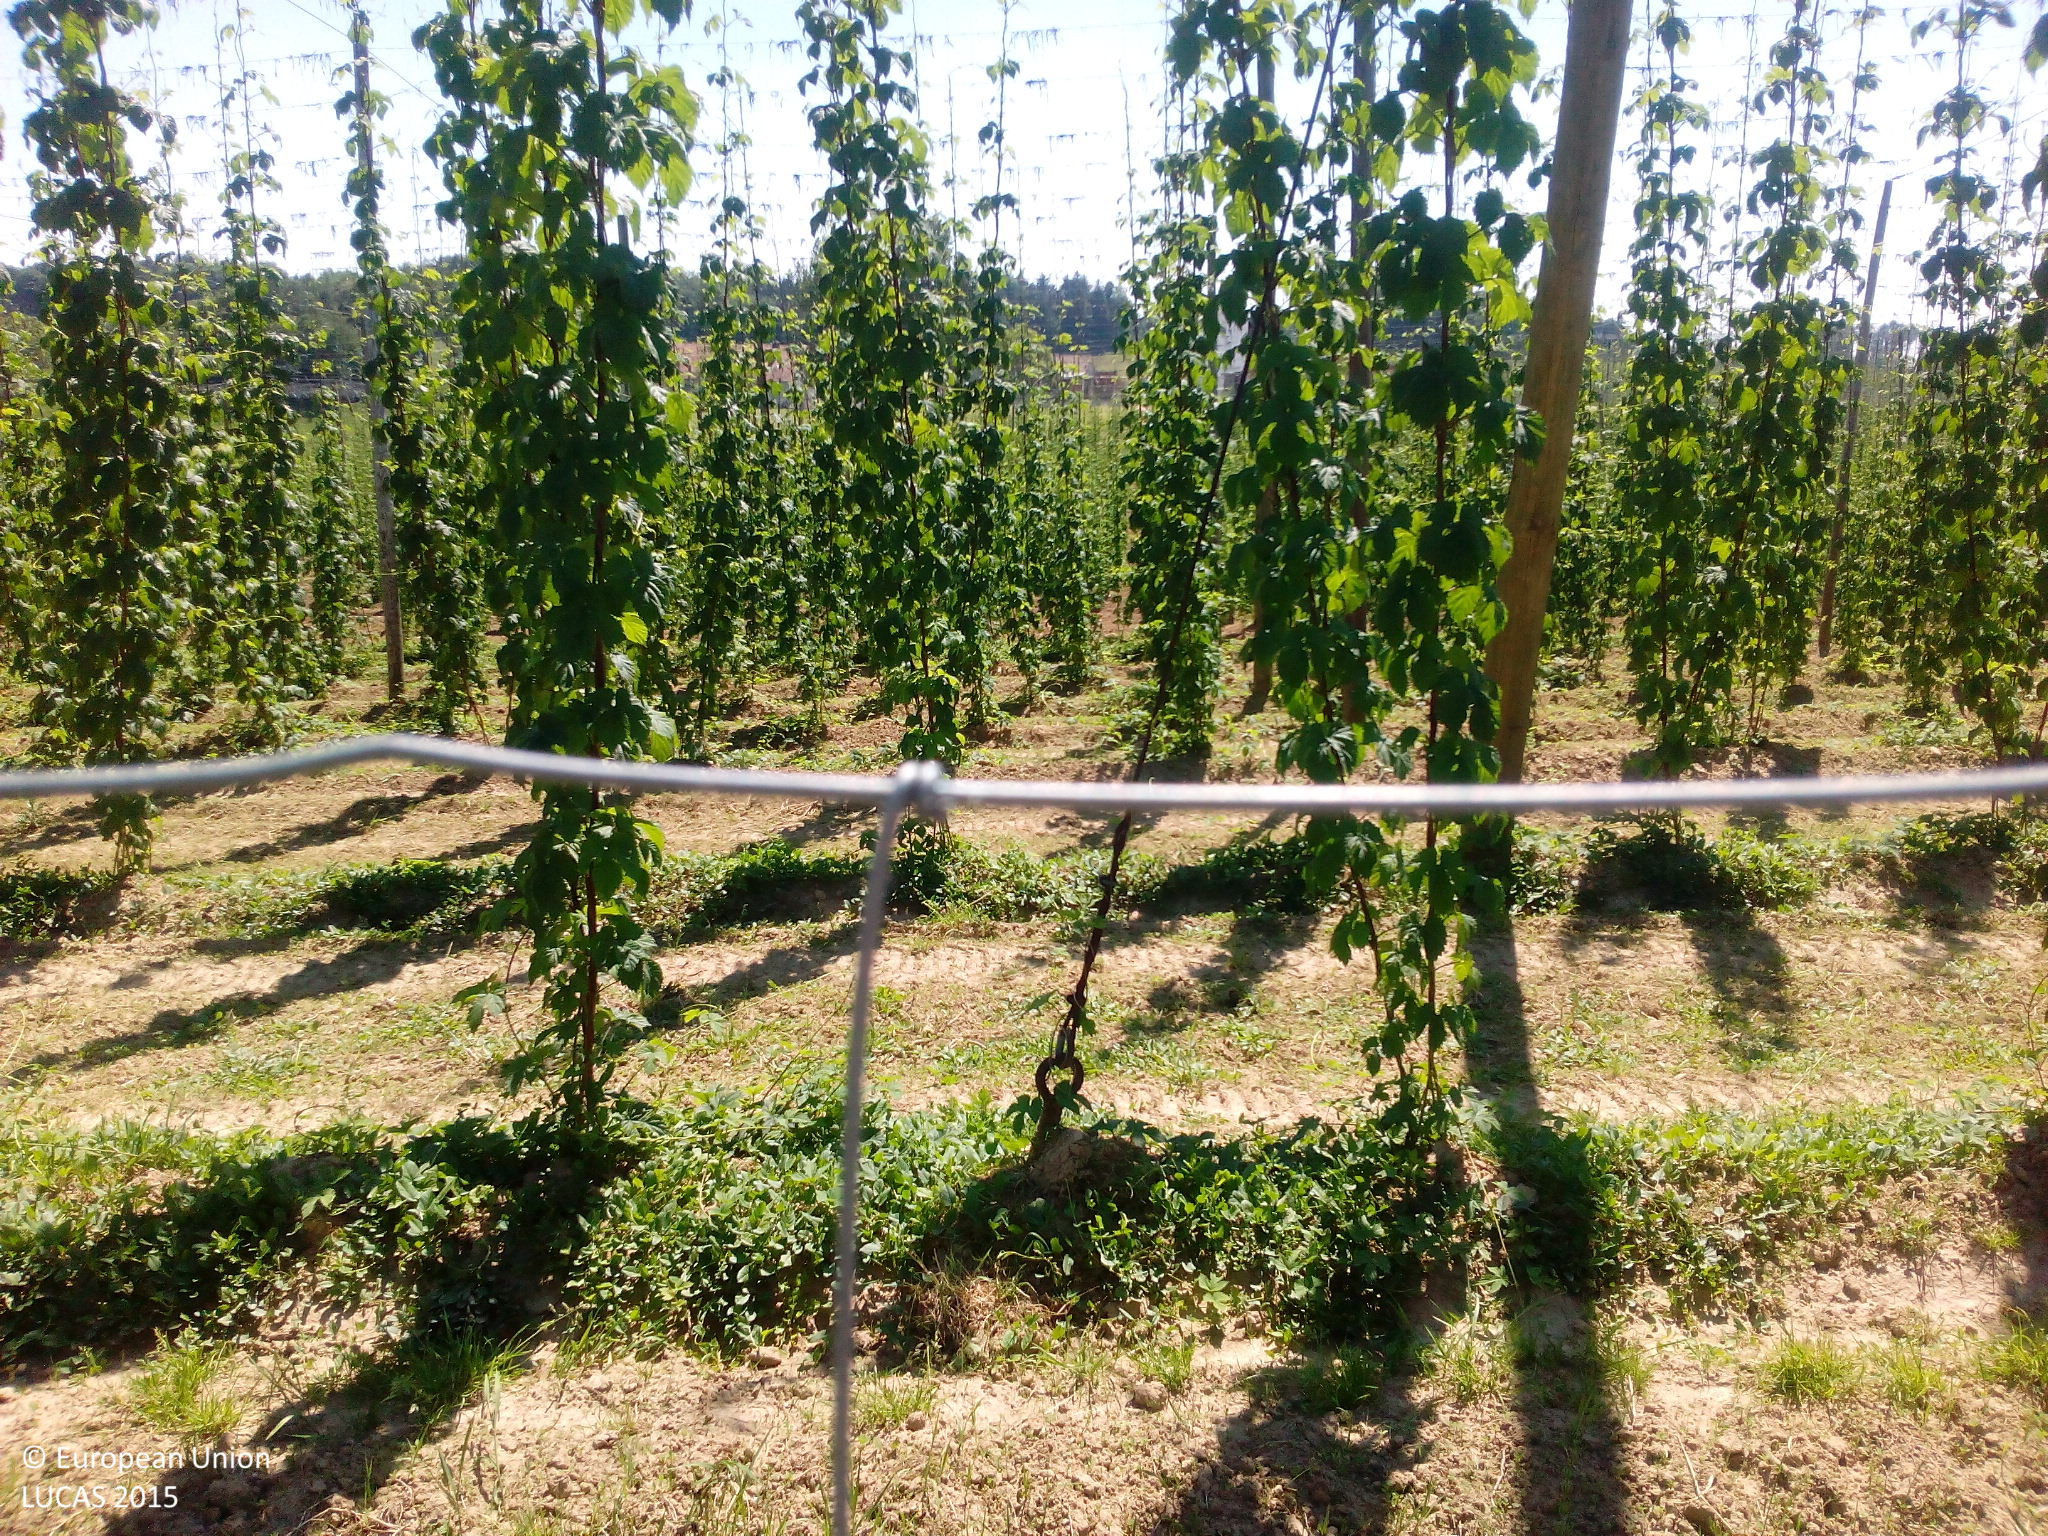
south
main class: Cropland
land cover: Rape and turnip rape
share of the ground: > 75 %
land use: Agriculture (excluding fallow land and kitchen gardens)
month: June
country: DE
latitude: 48.6929
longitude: 11.9148
